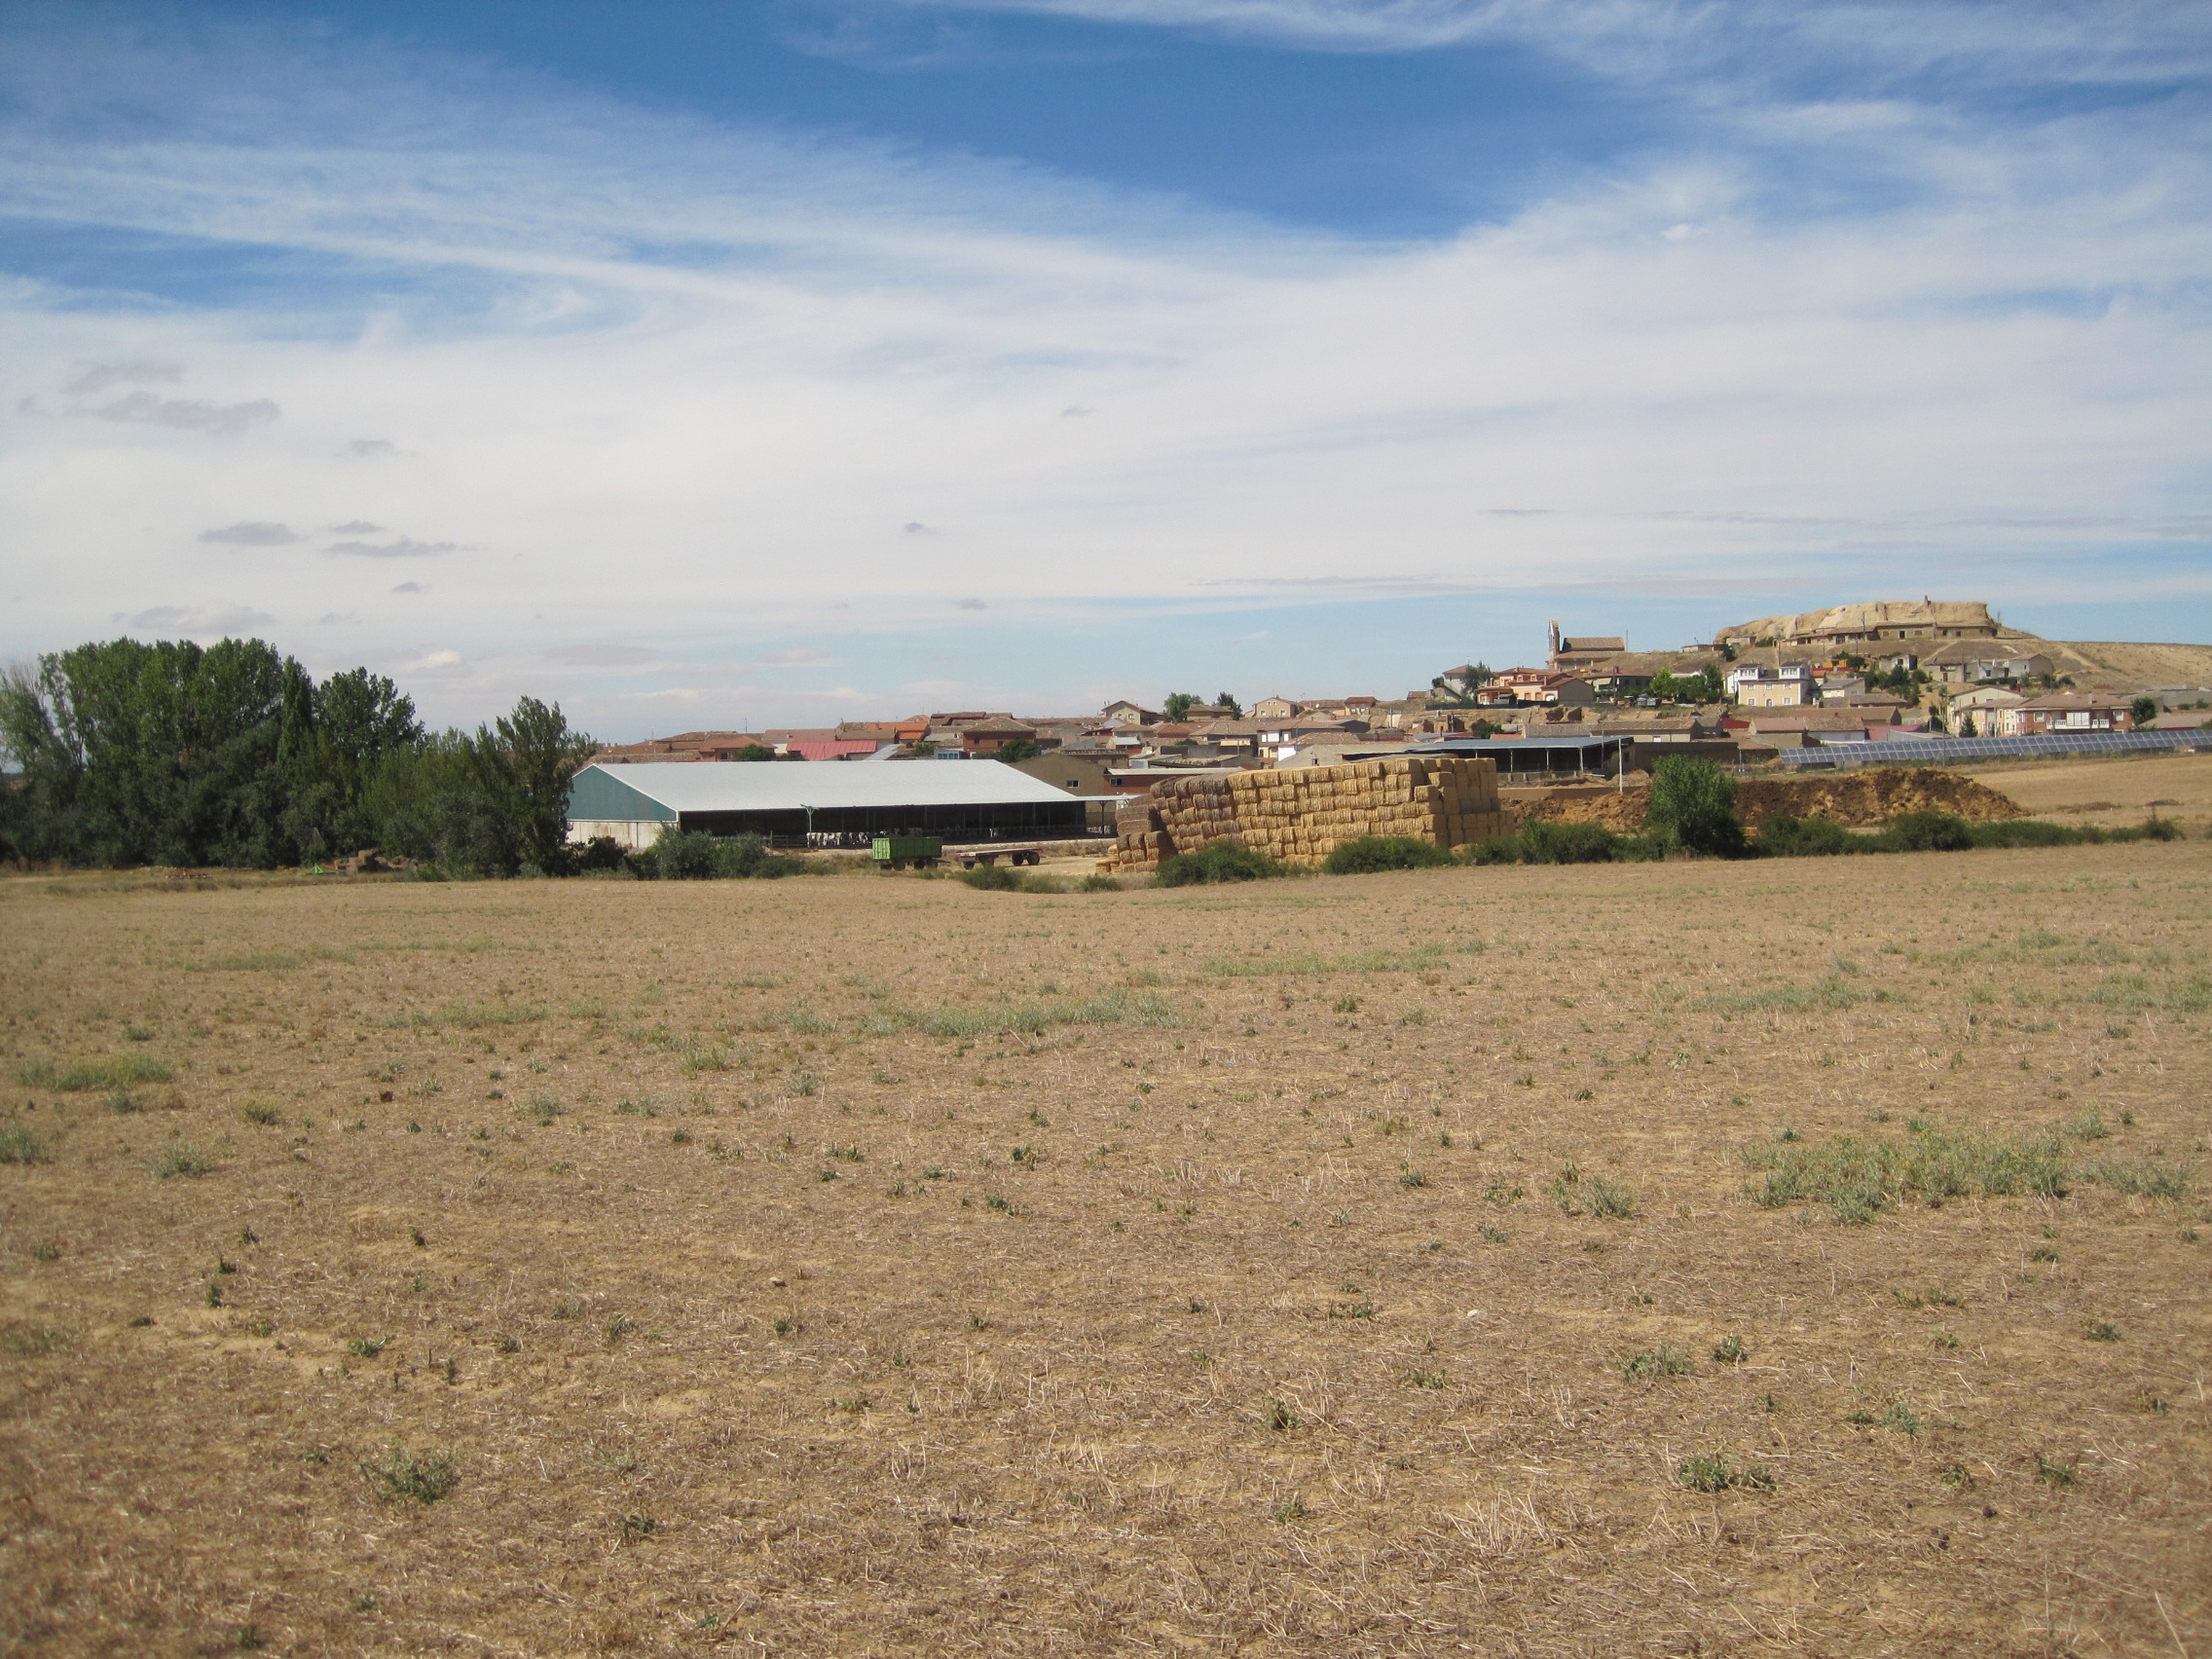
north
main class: Cropland
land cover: Dry pulses
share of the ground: < 10 %
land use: Agriculture (excluding fallow land and kitchen gardens)
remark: Harvested field
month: July
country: ES
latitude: 41.9792
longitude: -5.1797
